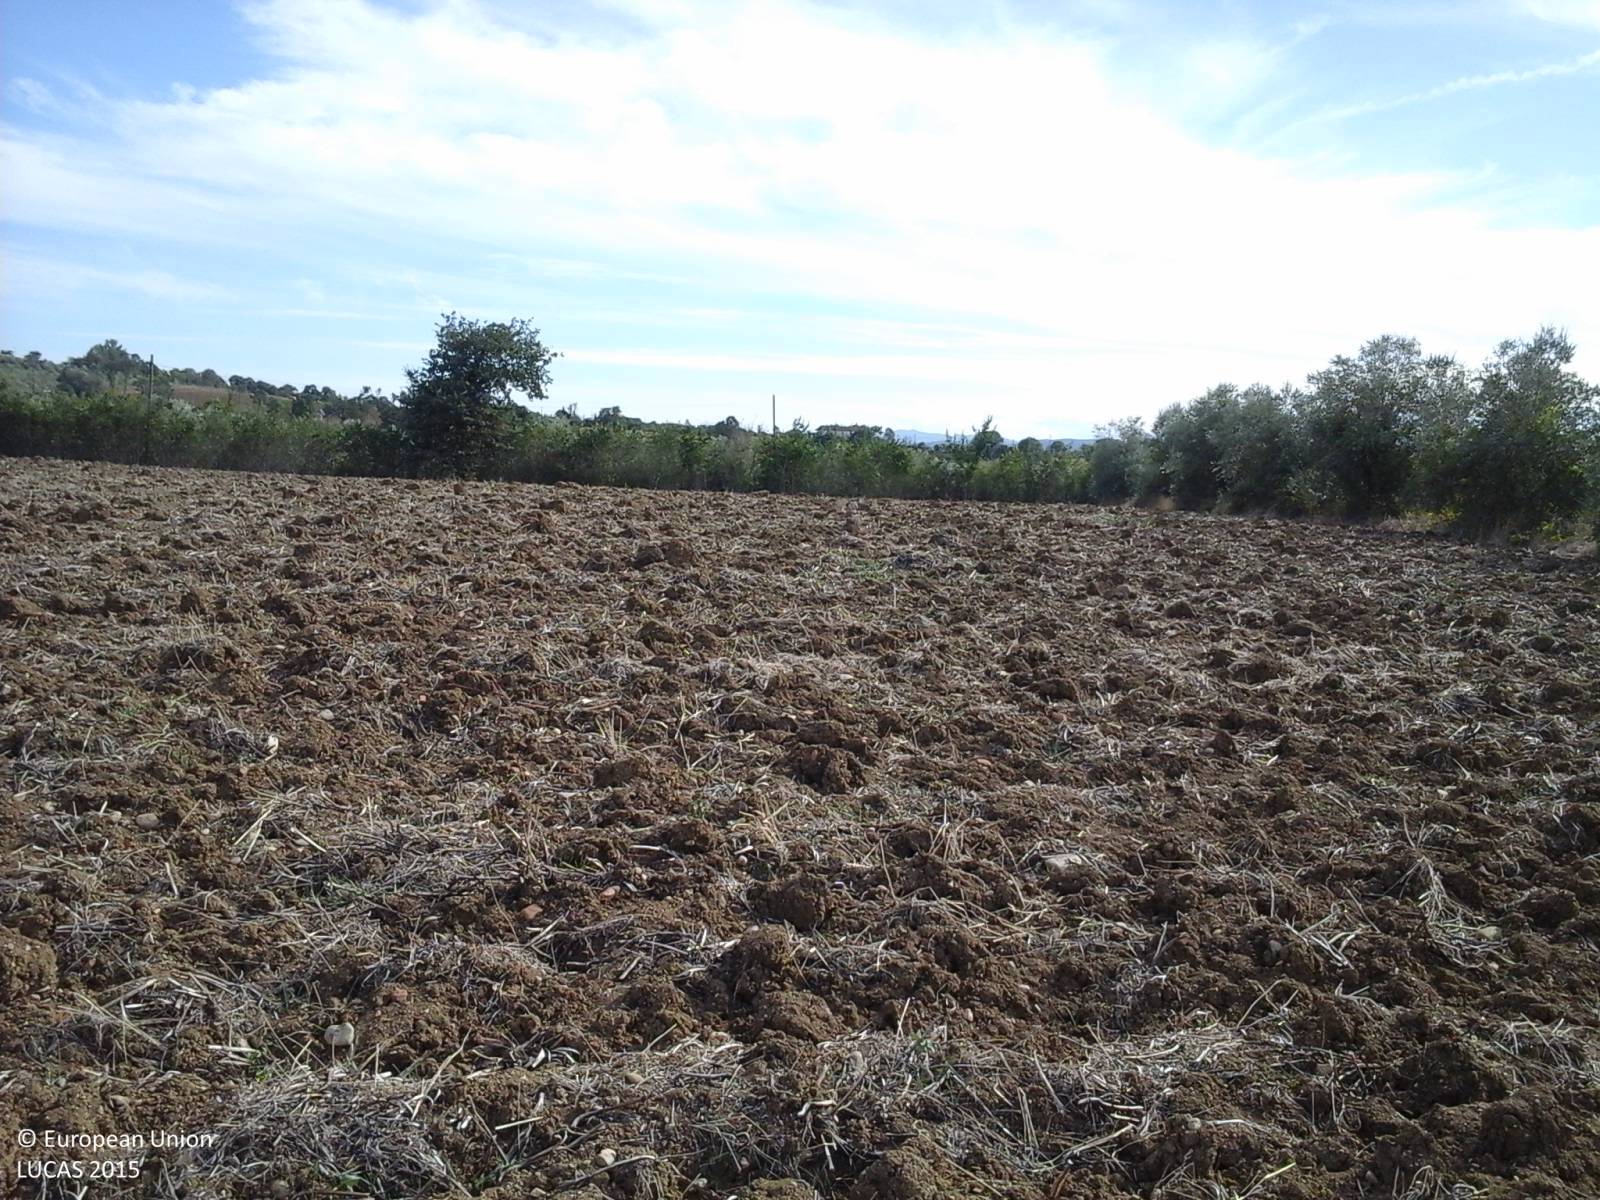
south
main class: Cropland
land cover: Dry pulses
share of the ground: < 10 %
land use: Agriculture (excluding fallow land and kitchen gardens)
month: September
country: IT
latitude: 42.9686
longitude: 12.4081
